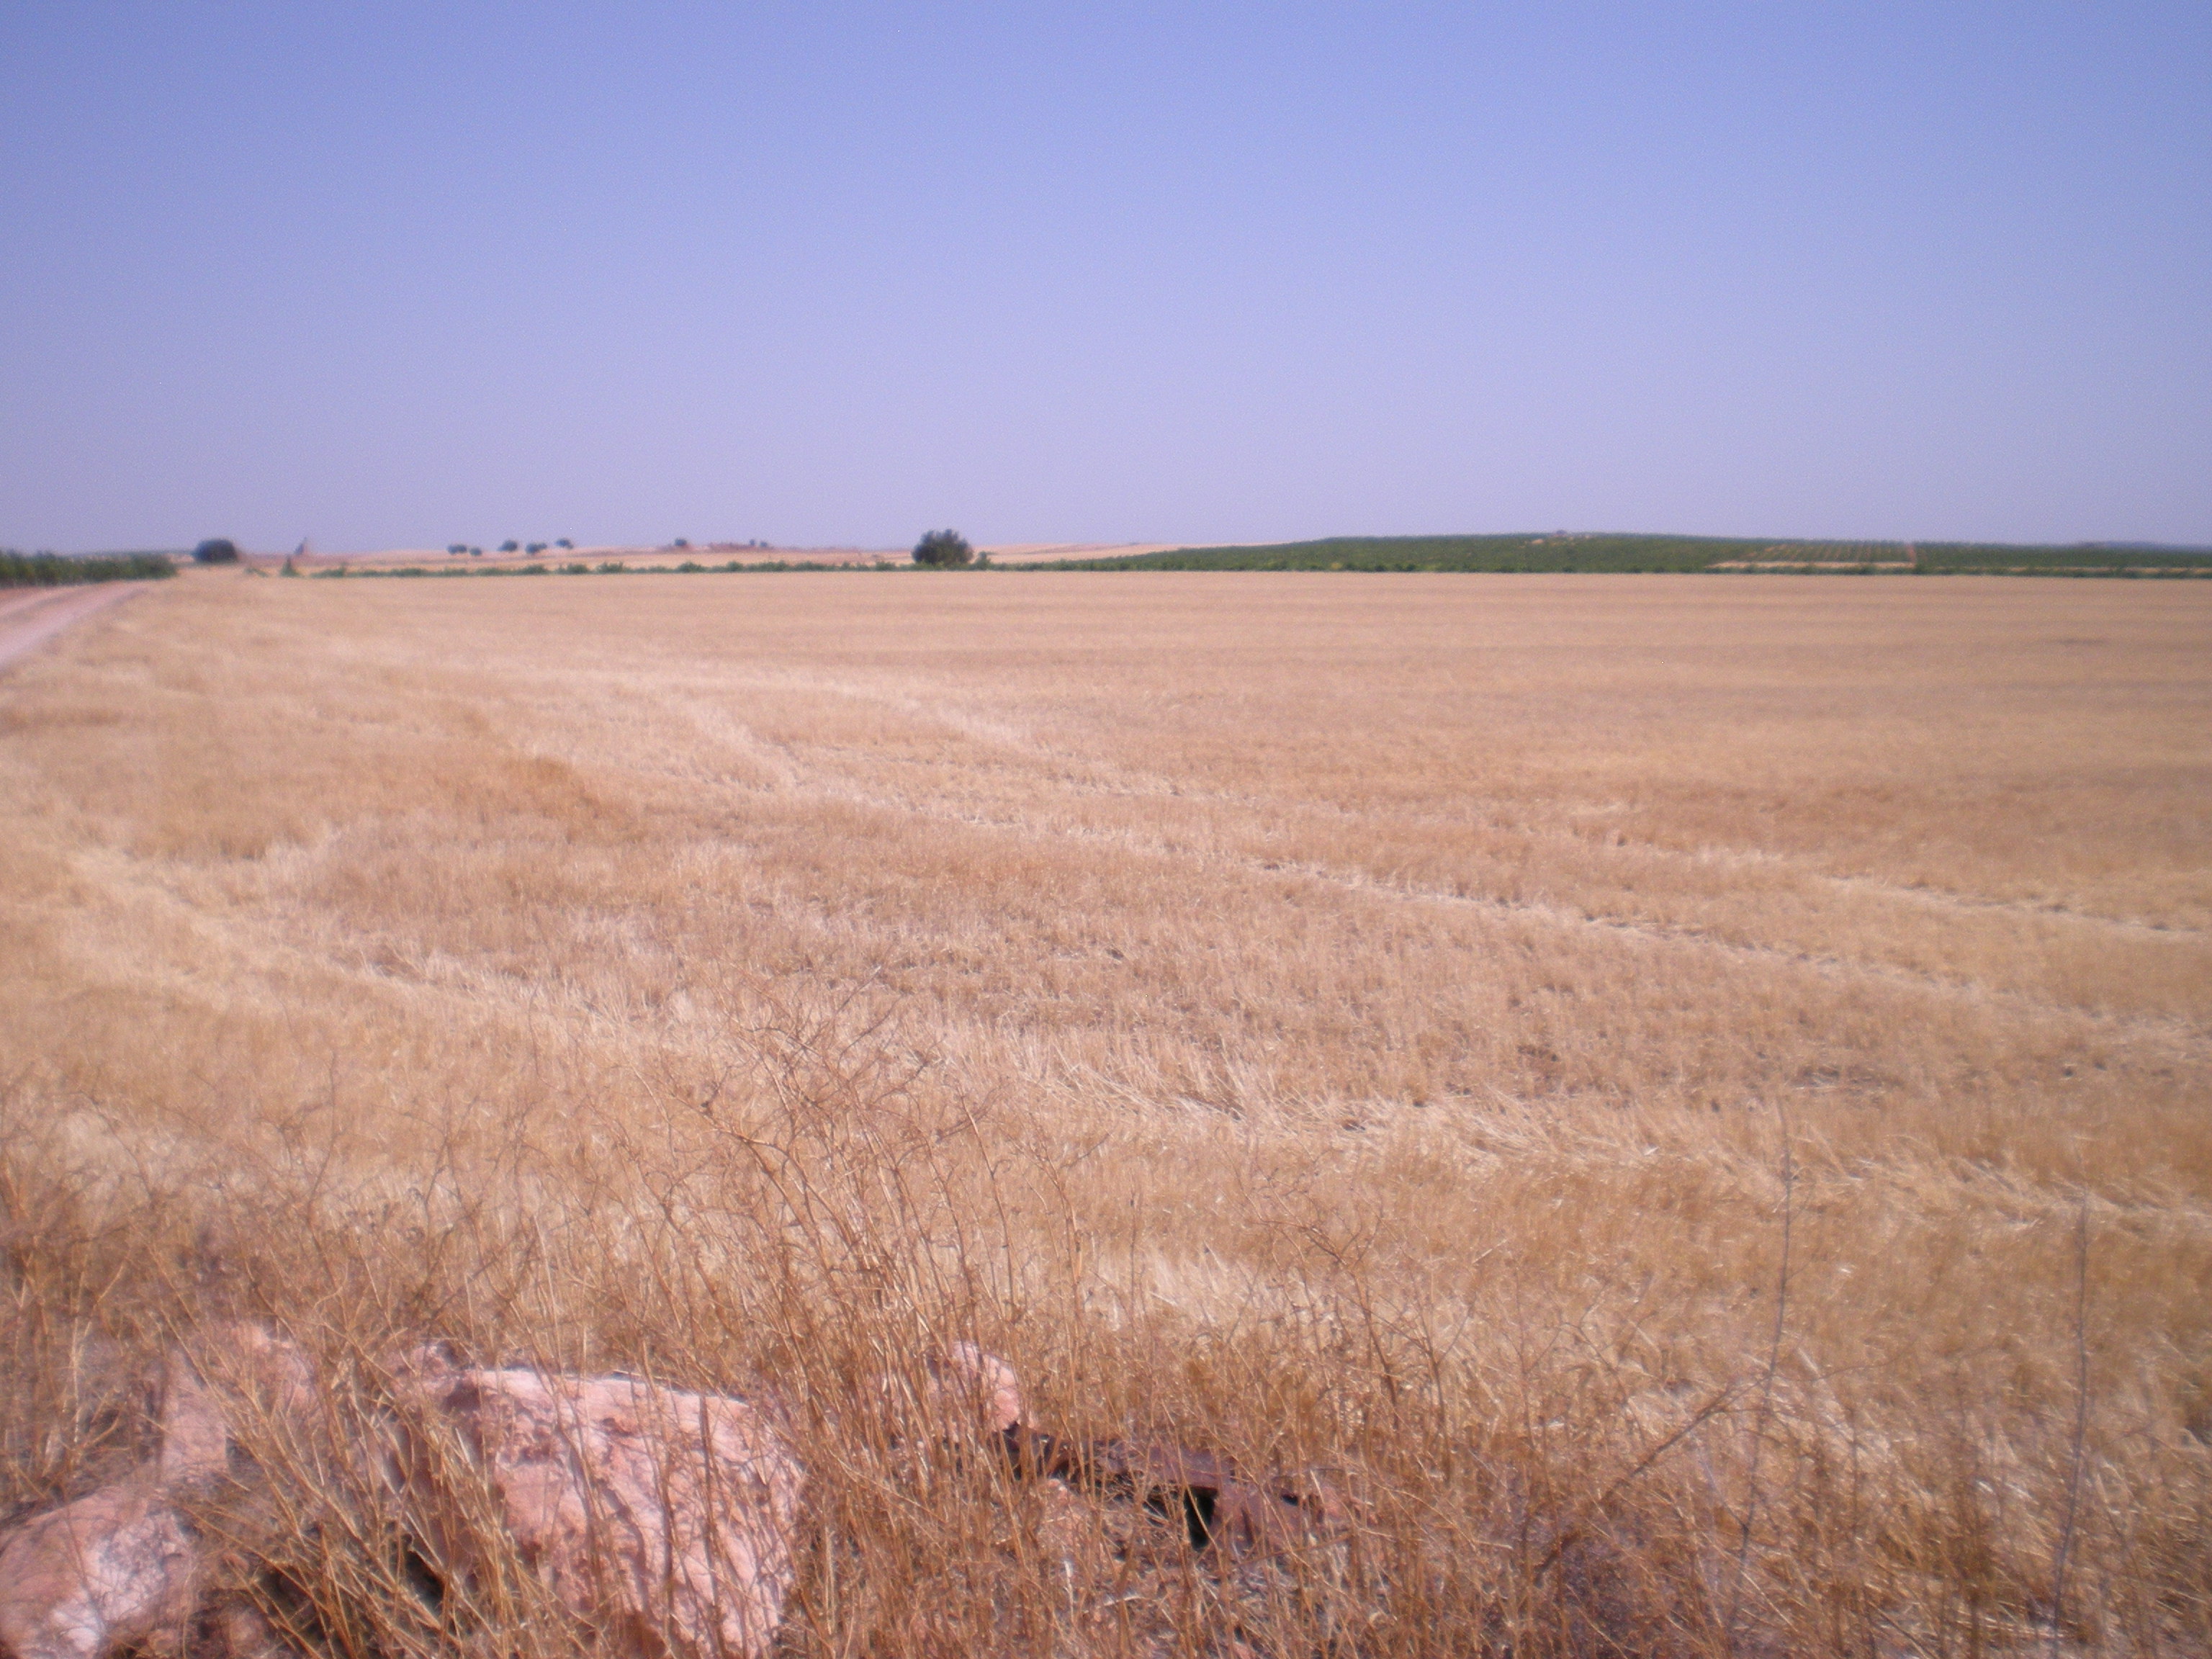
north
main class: Cropland
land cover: Barley
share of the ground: < 10 %
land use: Agriculture (excluding fallow land and kitchen gardens)
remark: Harvested field
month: July
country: ES
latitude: 39.4791
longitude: -3.2140
